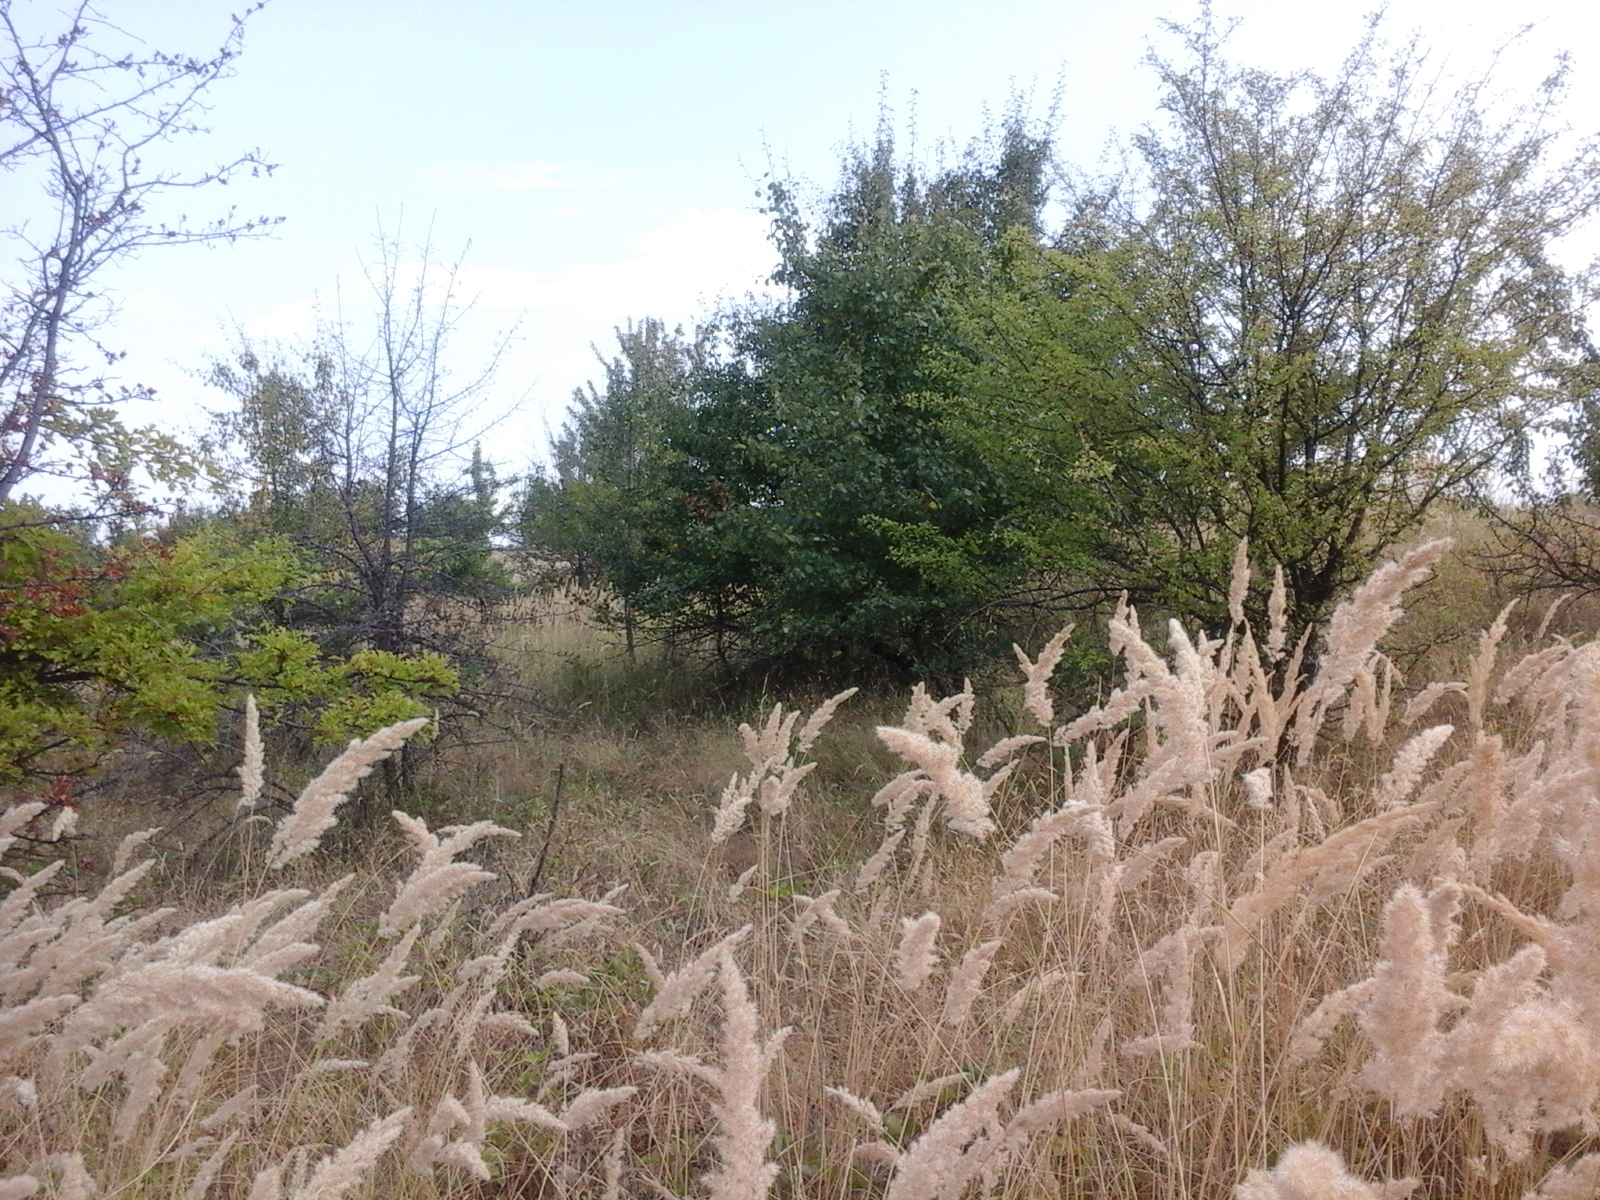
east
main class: Grassland
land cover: Spontaneously vegetated surfaces
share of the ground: > 75 %
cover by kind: herbaceous plants 100 %
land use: Agriculture (excluding fallow land and kitchen gardens)
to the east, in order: Spontaneously vegetated surfaces; Tracks; Grassland with sparse tree/shrub cover
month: August
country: RO
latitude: 44.5951
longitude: 23.3675
